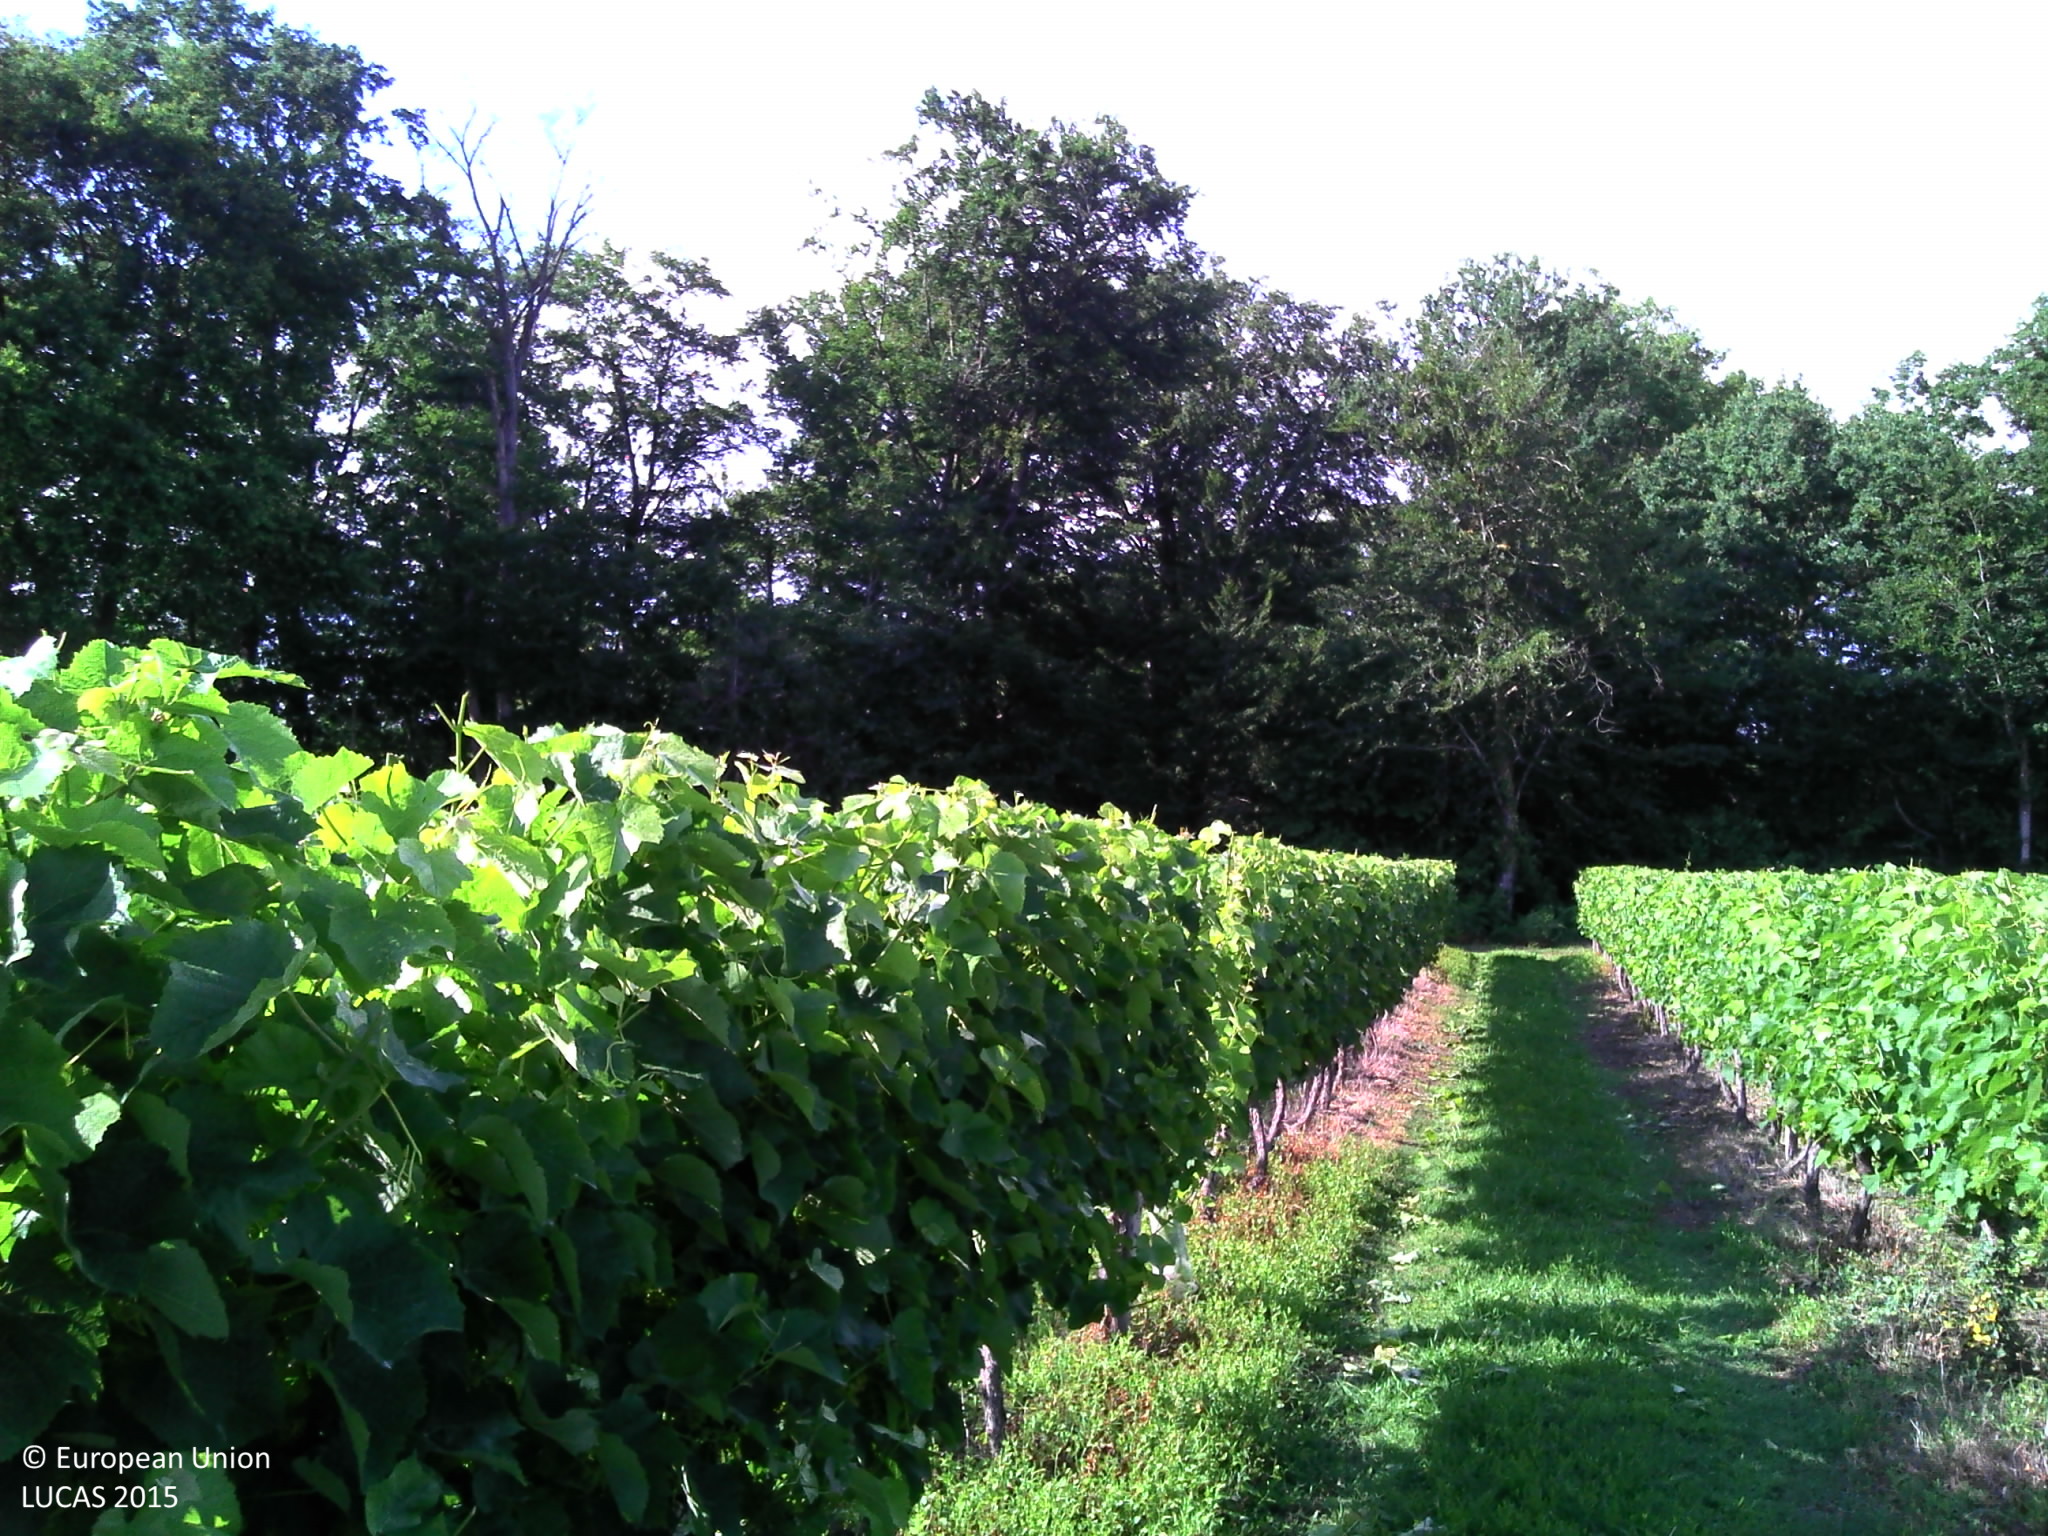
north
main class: Cropland
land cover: Vineyards
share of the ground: 25 - 50 %
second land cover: Grassland without tree/shrub cover
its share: 25 - 50 %
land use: Agriculture (excluding fallow land and kitchen gardens)
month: June
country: FR
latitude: 43.8421
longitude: -0.2459
